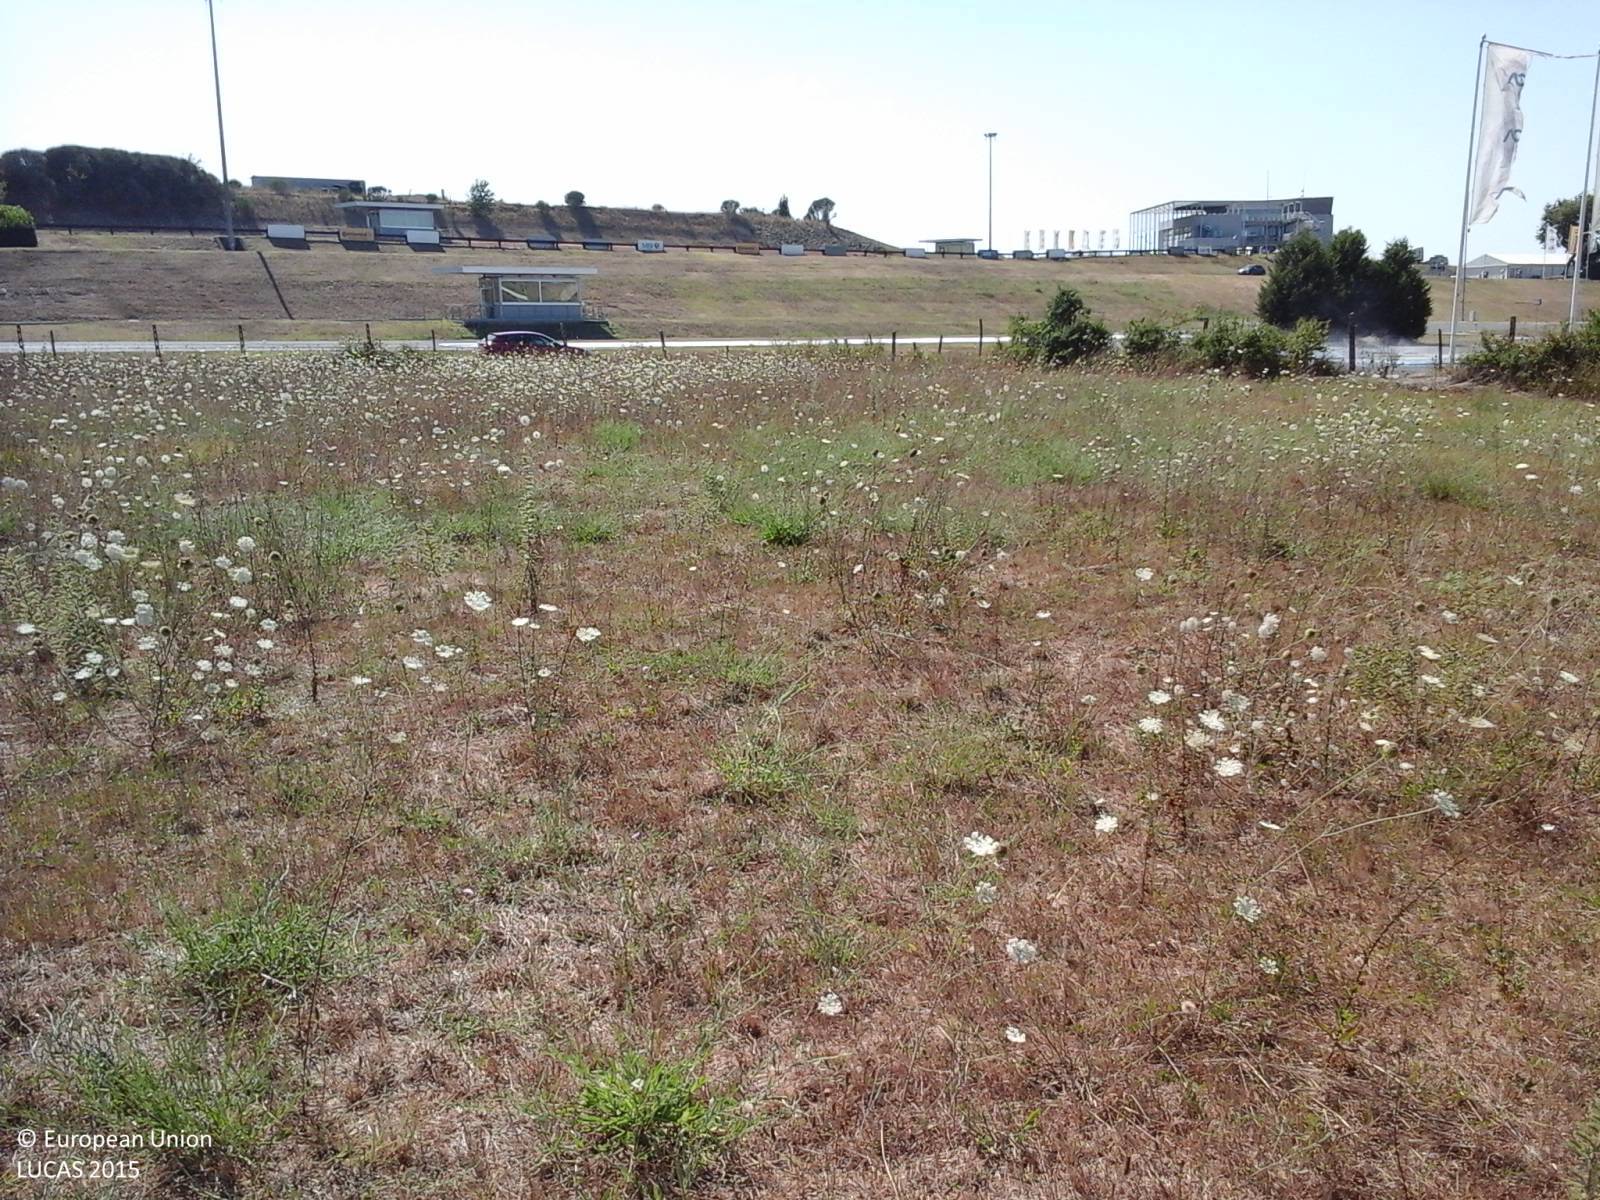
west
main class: Grassland
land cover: Grassland without tree/shrub cover
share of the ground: > 75 %
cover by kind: herbaceous plants 100 %
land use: Agriculture (excluding fallow land and kitchen gardens)
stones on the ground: < 10 %
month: July
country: IT
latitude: 42.1563
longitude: 12.3757
